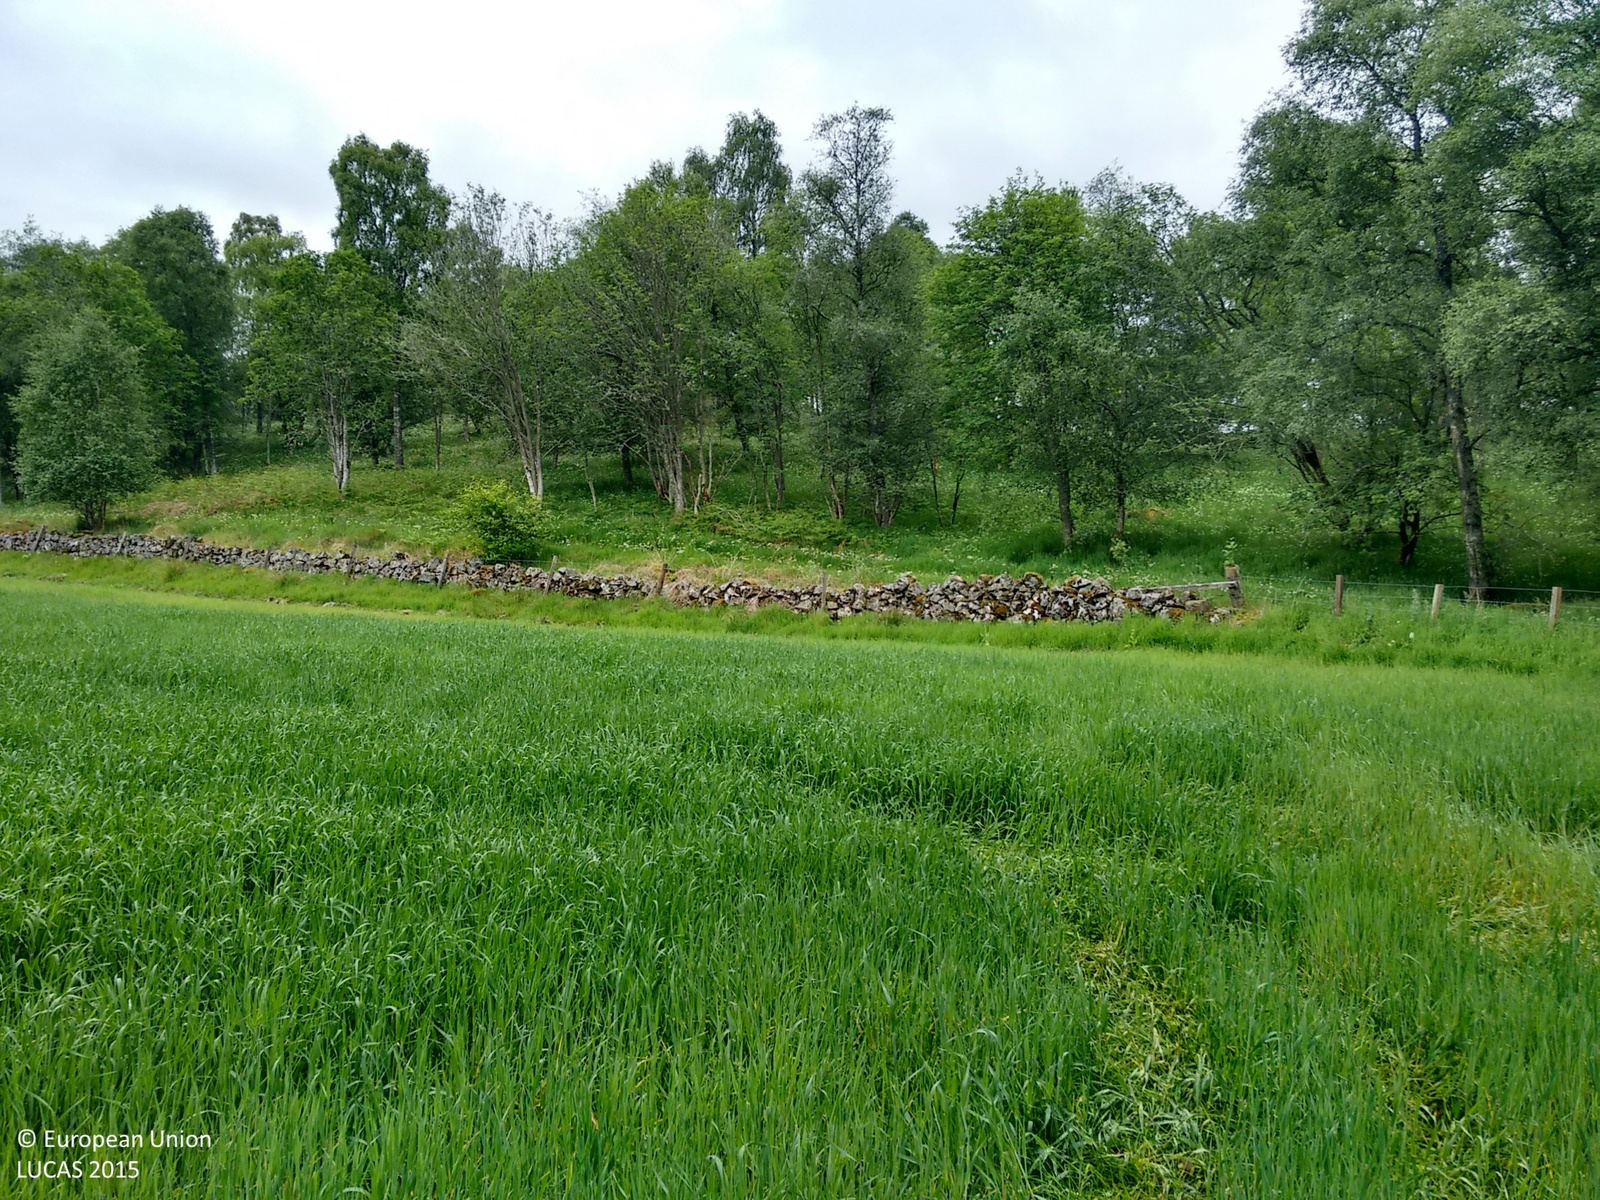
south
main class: Cropland
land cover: Barley
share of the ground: > 75 %
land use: Agriculture (excluding fallow land and kitchen gardens)
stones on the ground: < 10 %
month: June
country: GB
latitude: 57.0515
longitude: -2.6690
